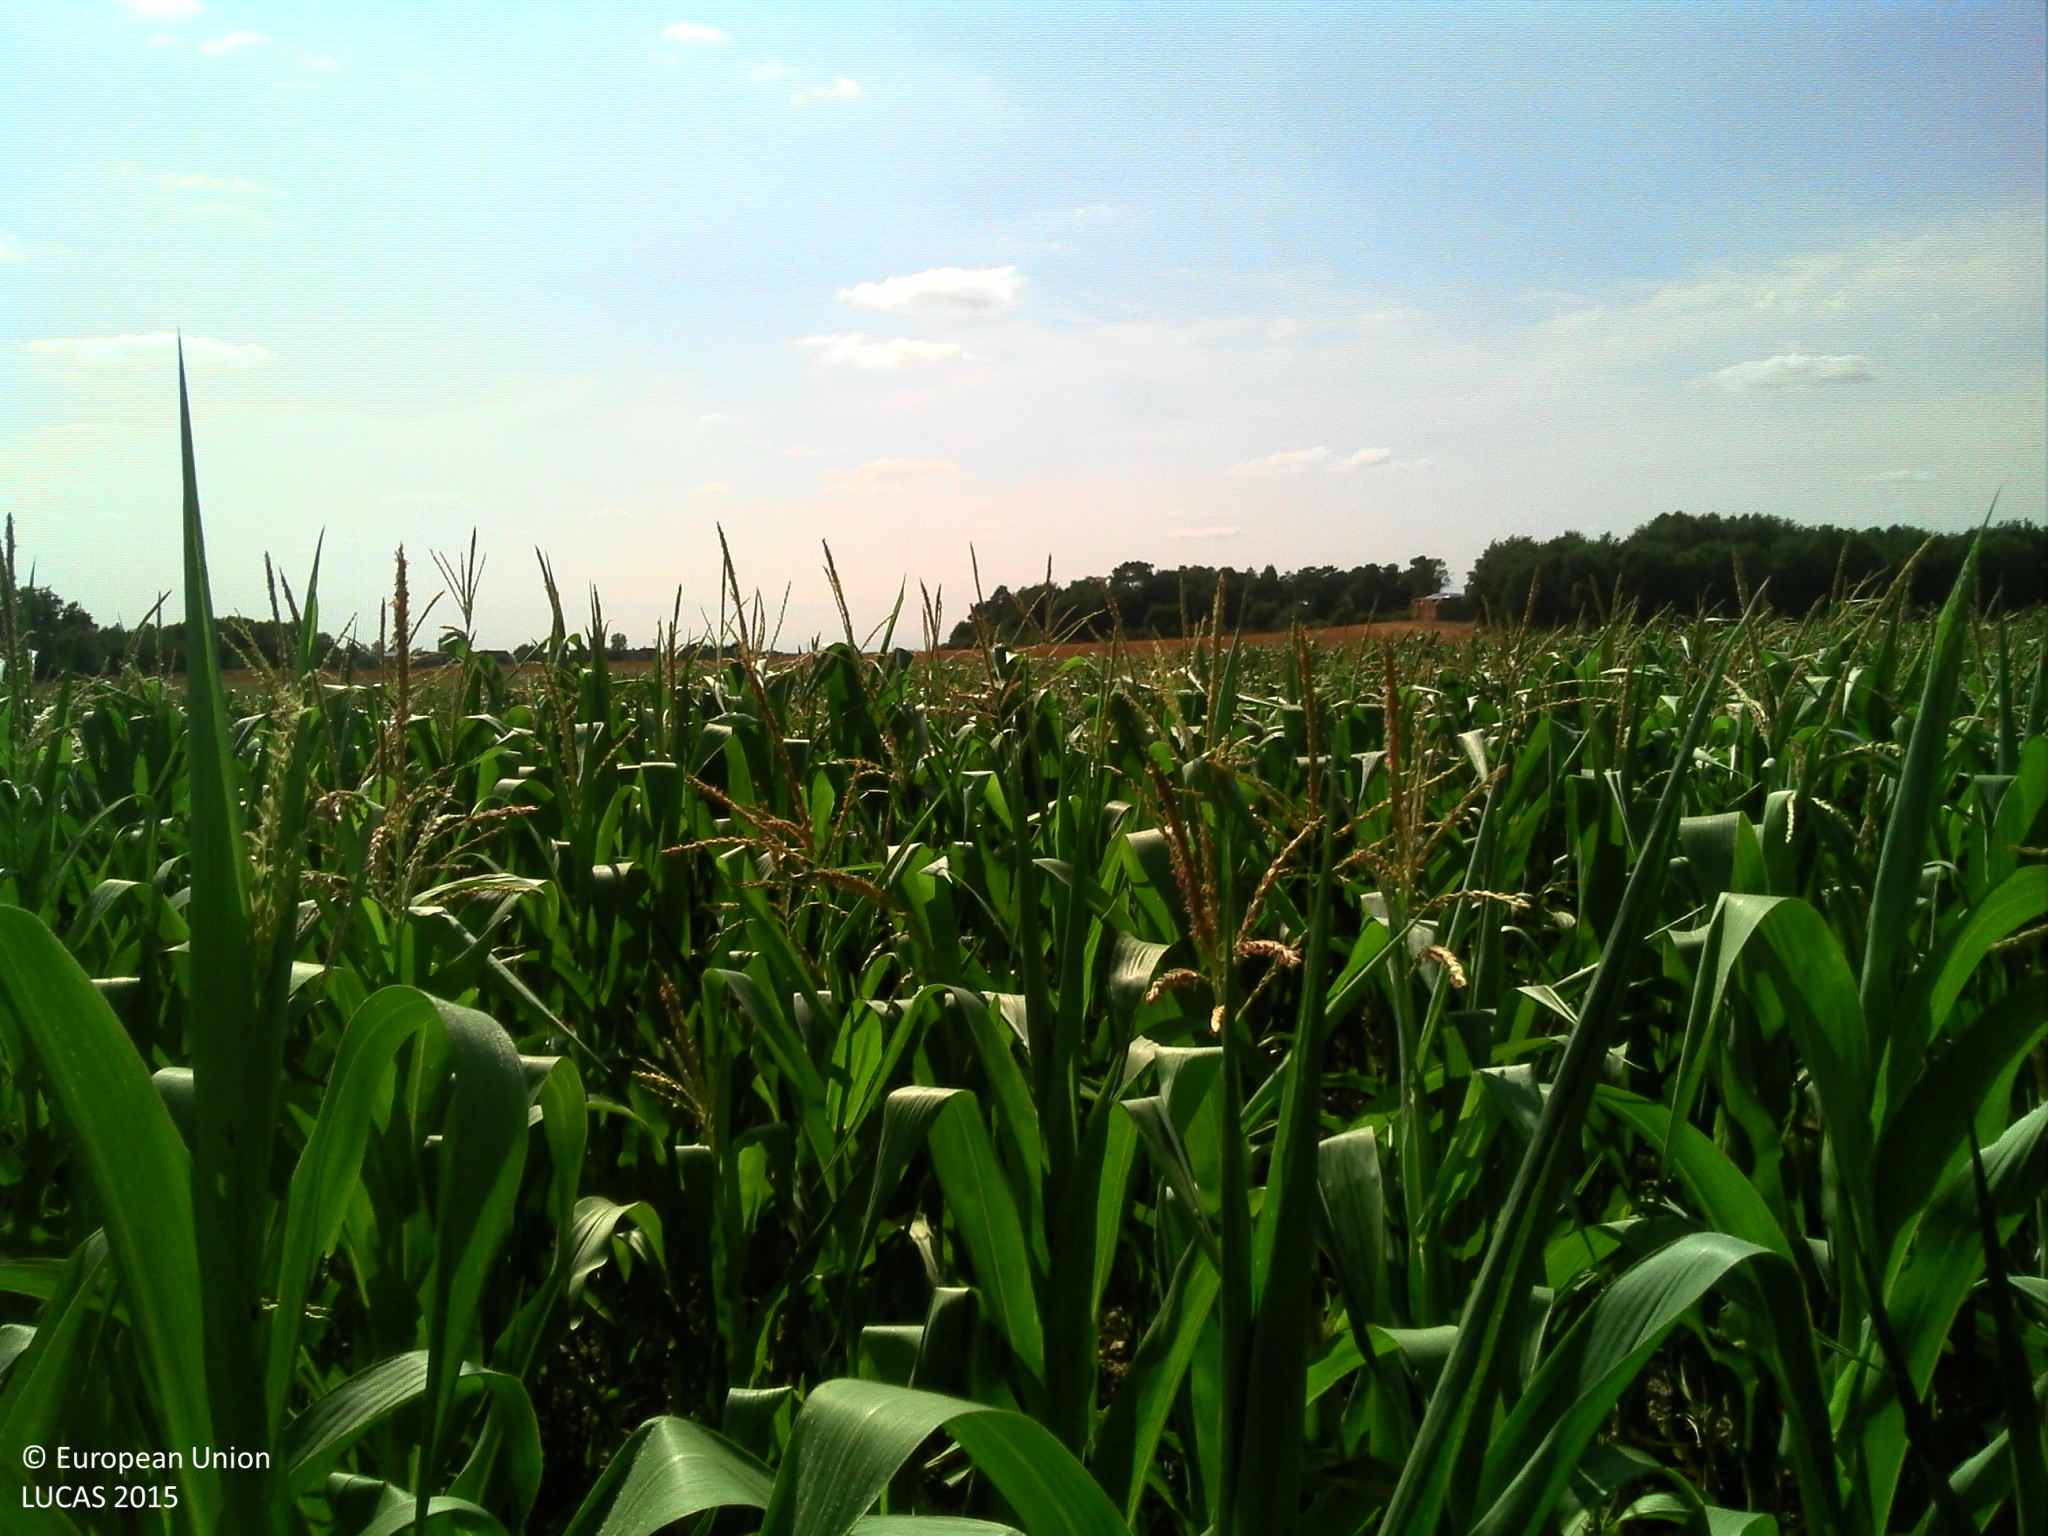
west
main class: Cropland
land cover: Maize
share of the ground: > 75 %
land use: Agriculture (excluding fallow land and kitchen gardens)
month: July
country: FR
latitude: 46.9505
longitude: 0.7989
